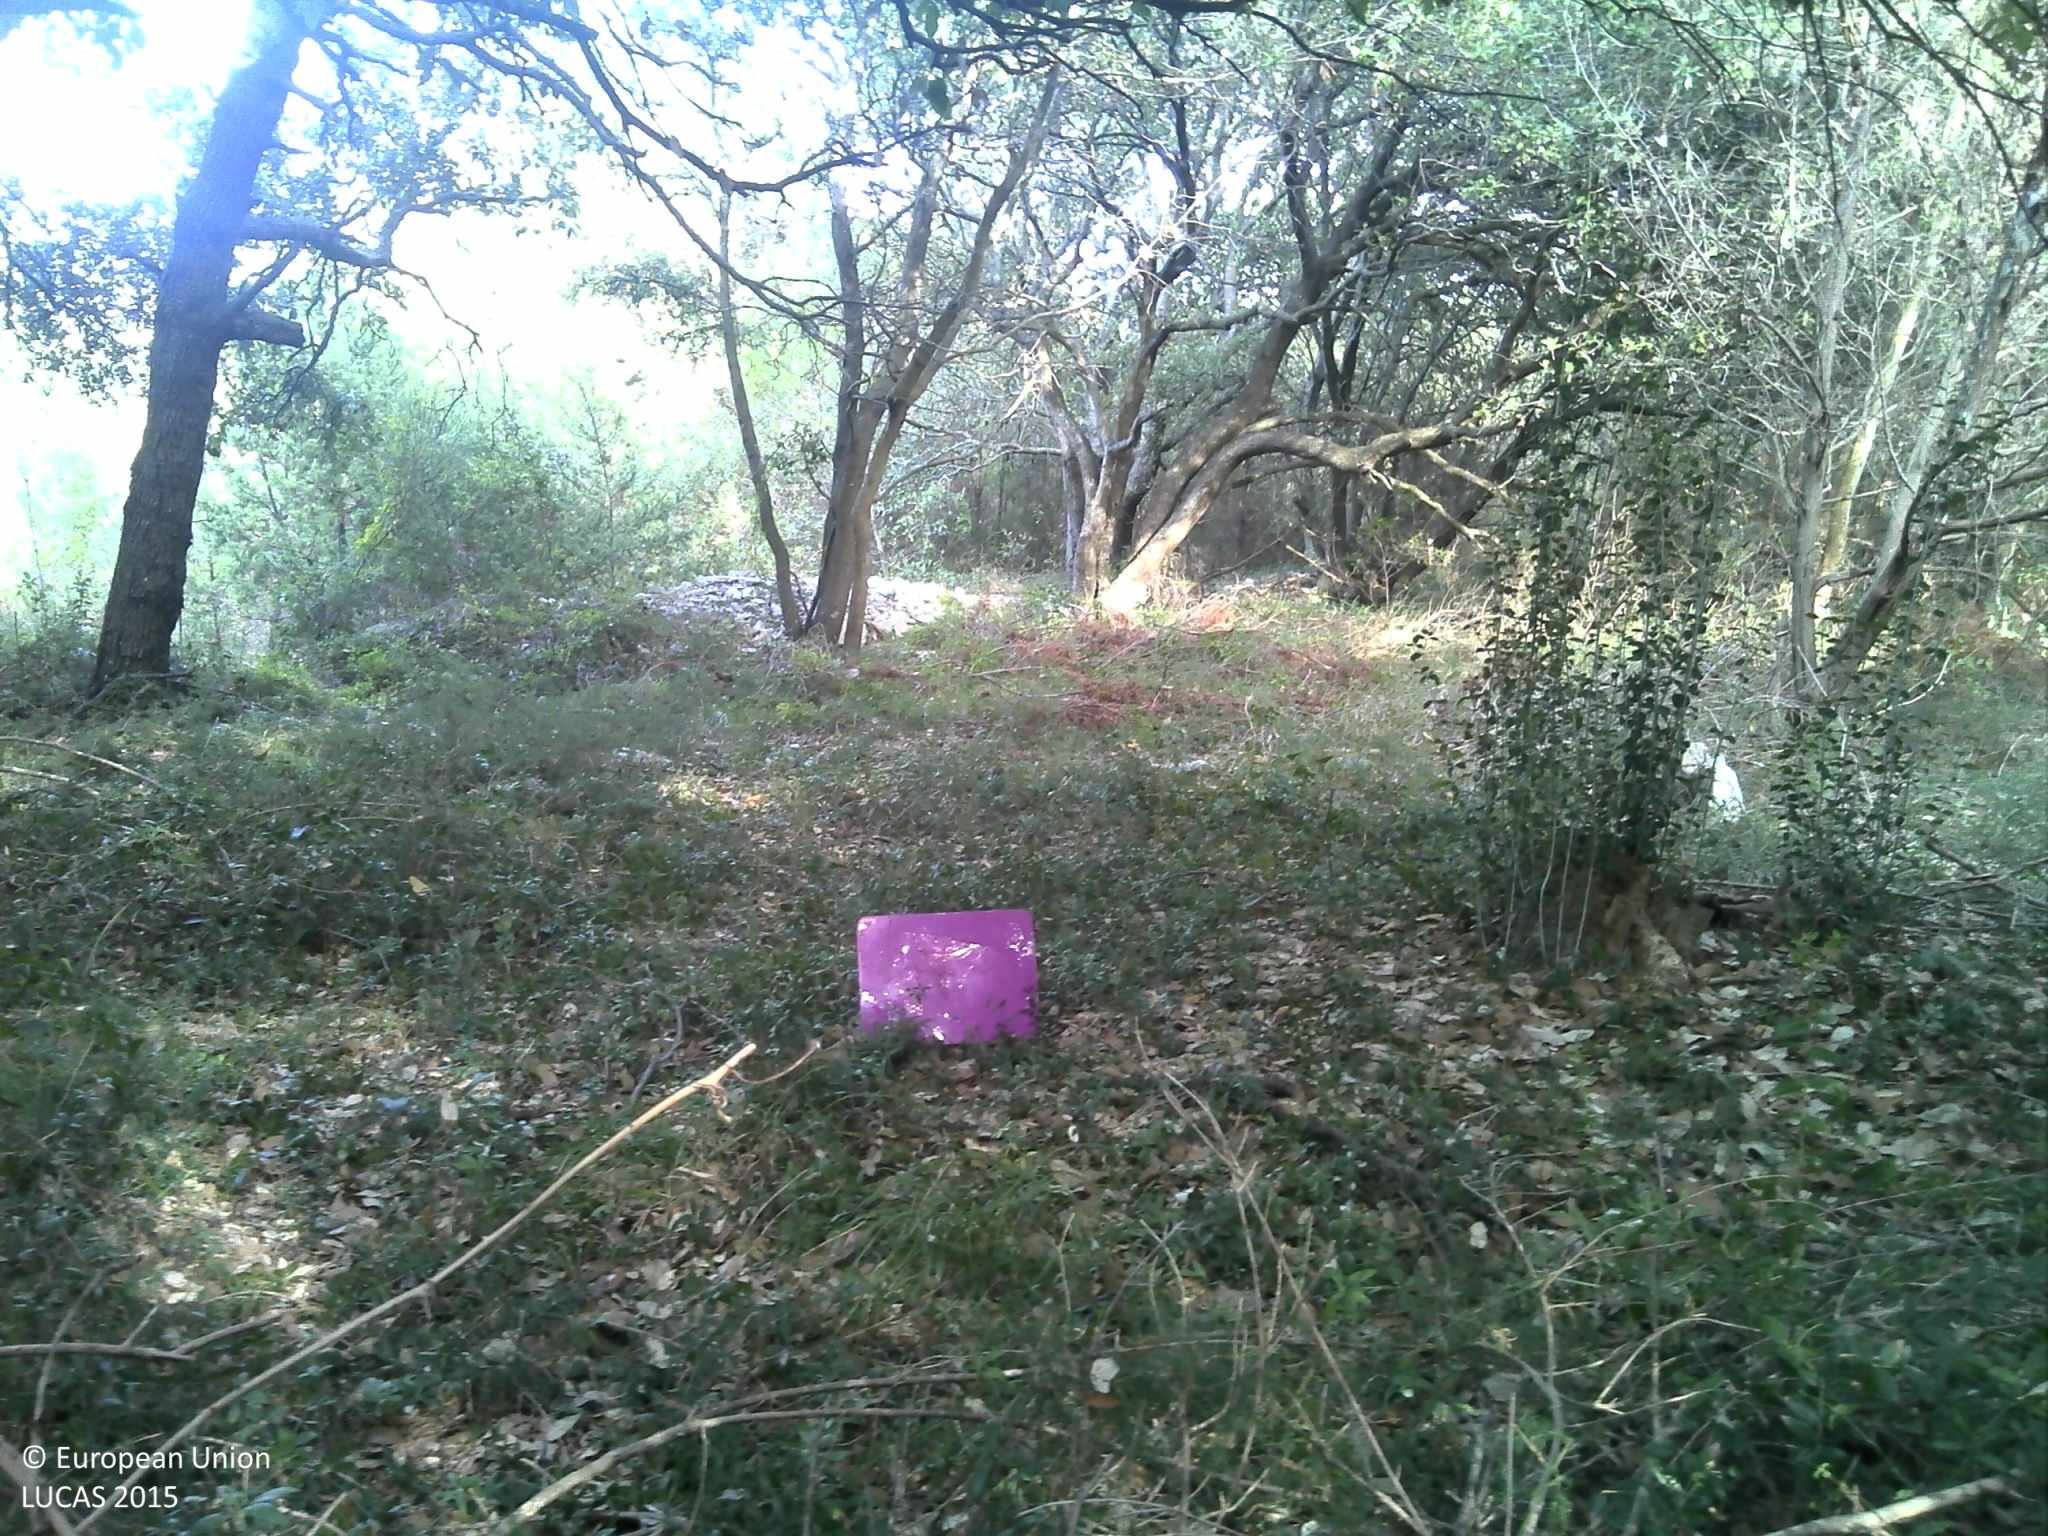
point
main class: Woodland
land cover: Pine dominated coniferous woodland
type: coniferous forest of the mediterranean region
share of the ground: > 75 %
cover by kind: coniferous forest trees 70 %, shrubs 10 %, herbaceous plants 10 %, broadleaved forest trees 5 %, consolidated bare surface 5 %
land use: Abandoned areas
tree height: > 5 m
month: September
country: HR
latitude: 44.1466
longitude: 14.8552
